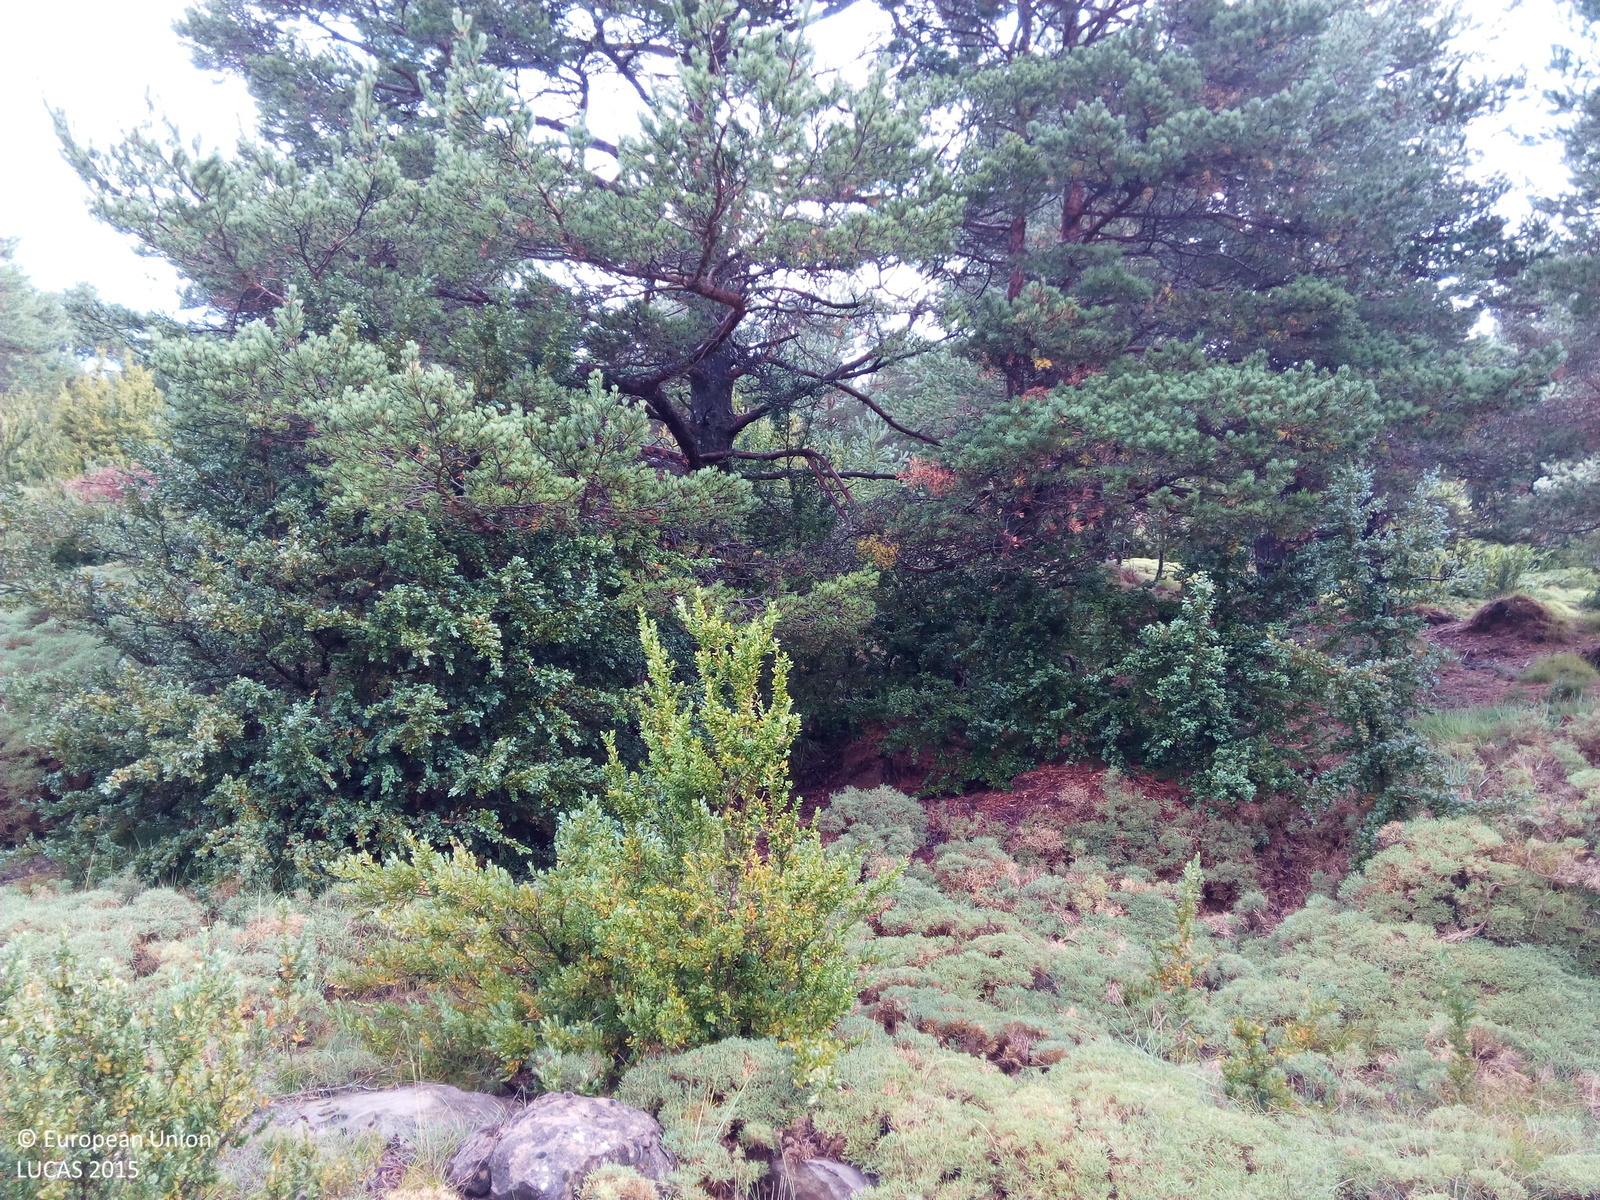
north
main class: Woodland
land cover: Pine dominated coniferous woodland
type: coniferous forest of the mediterranean region
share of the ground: > 75 %
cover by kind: coniferous forest trees 50 %, shrubs 40 %, herbaceous plants 10 %
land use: Agriculture (excluding fallow land and kitchen gardens)
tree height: > 5 m
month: September
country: ES
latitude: 42.4103
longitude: -0.0226
